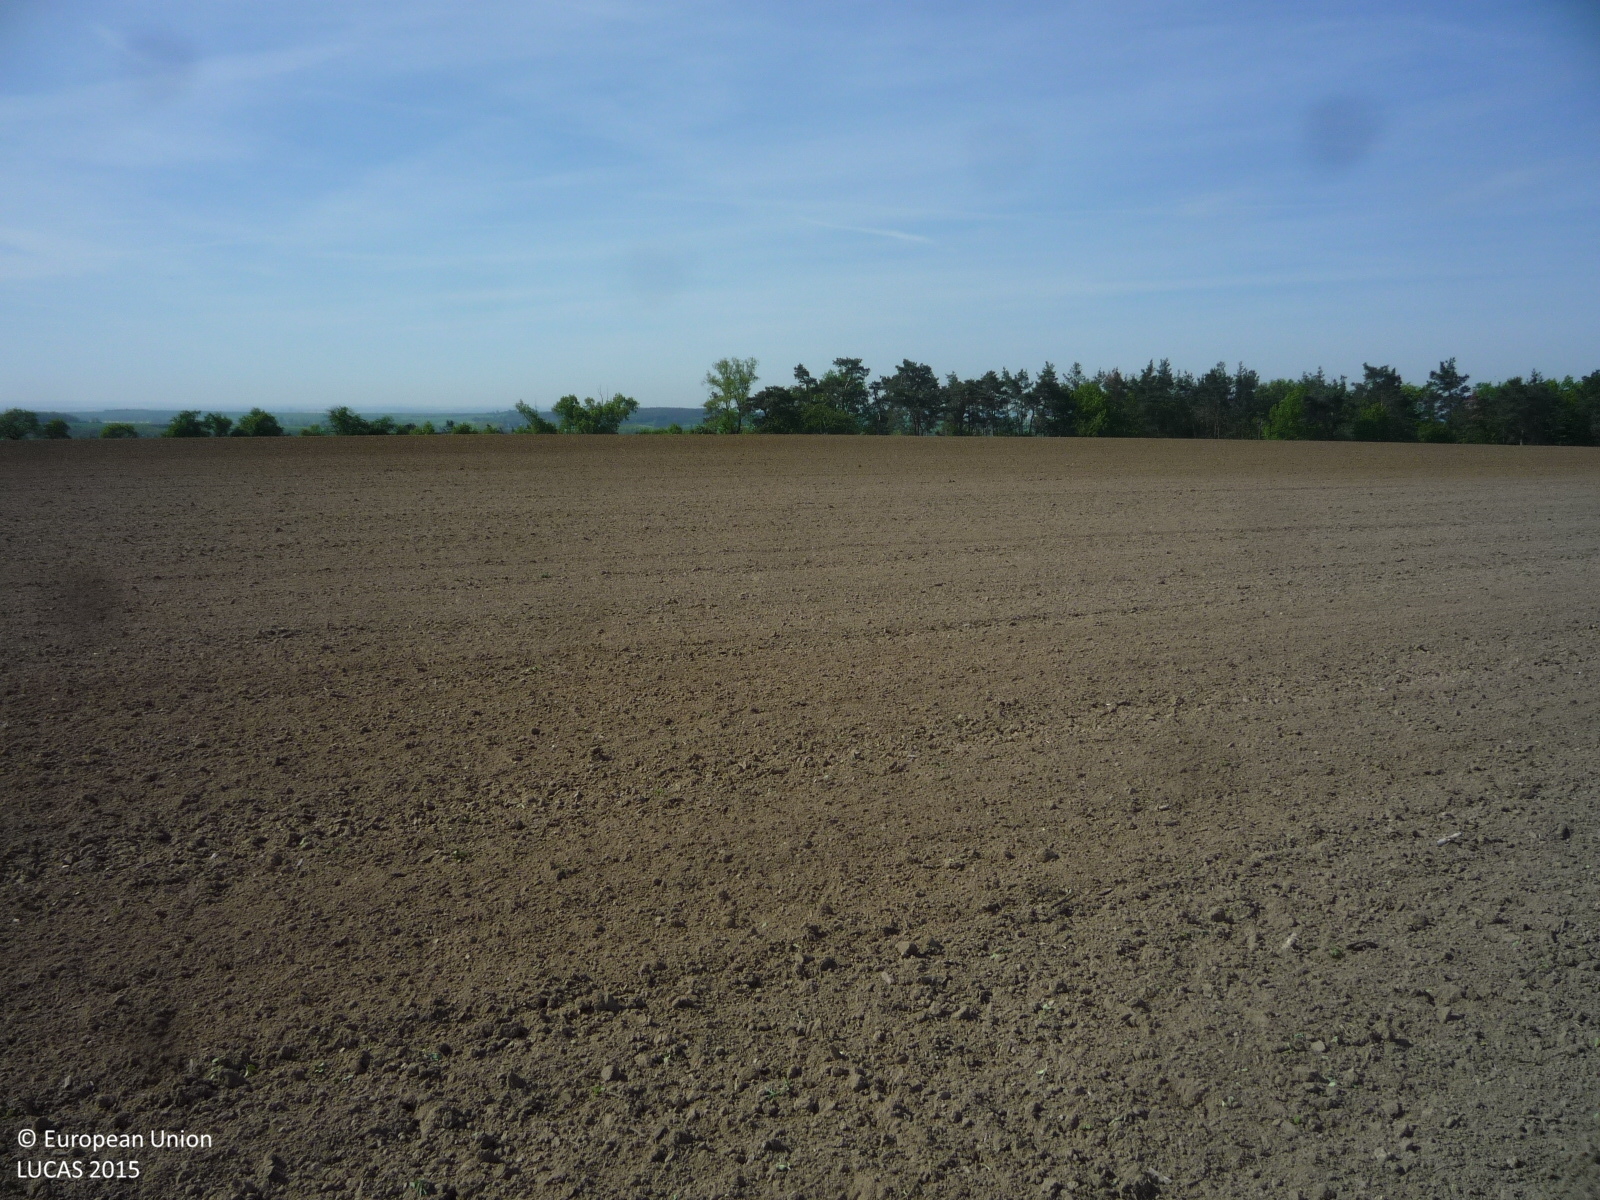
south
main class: Cropland
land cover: Dry pulses
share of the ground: < 10 %
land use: Agriculture (excluding fallow land and kitchen gardens)
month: May
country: CZ
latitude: 50.3639
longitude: 14.5425
